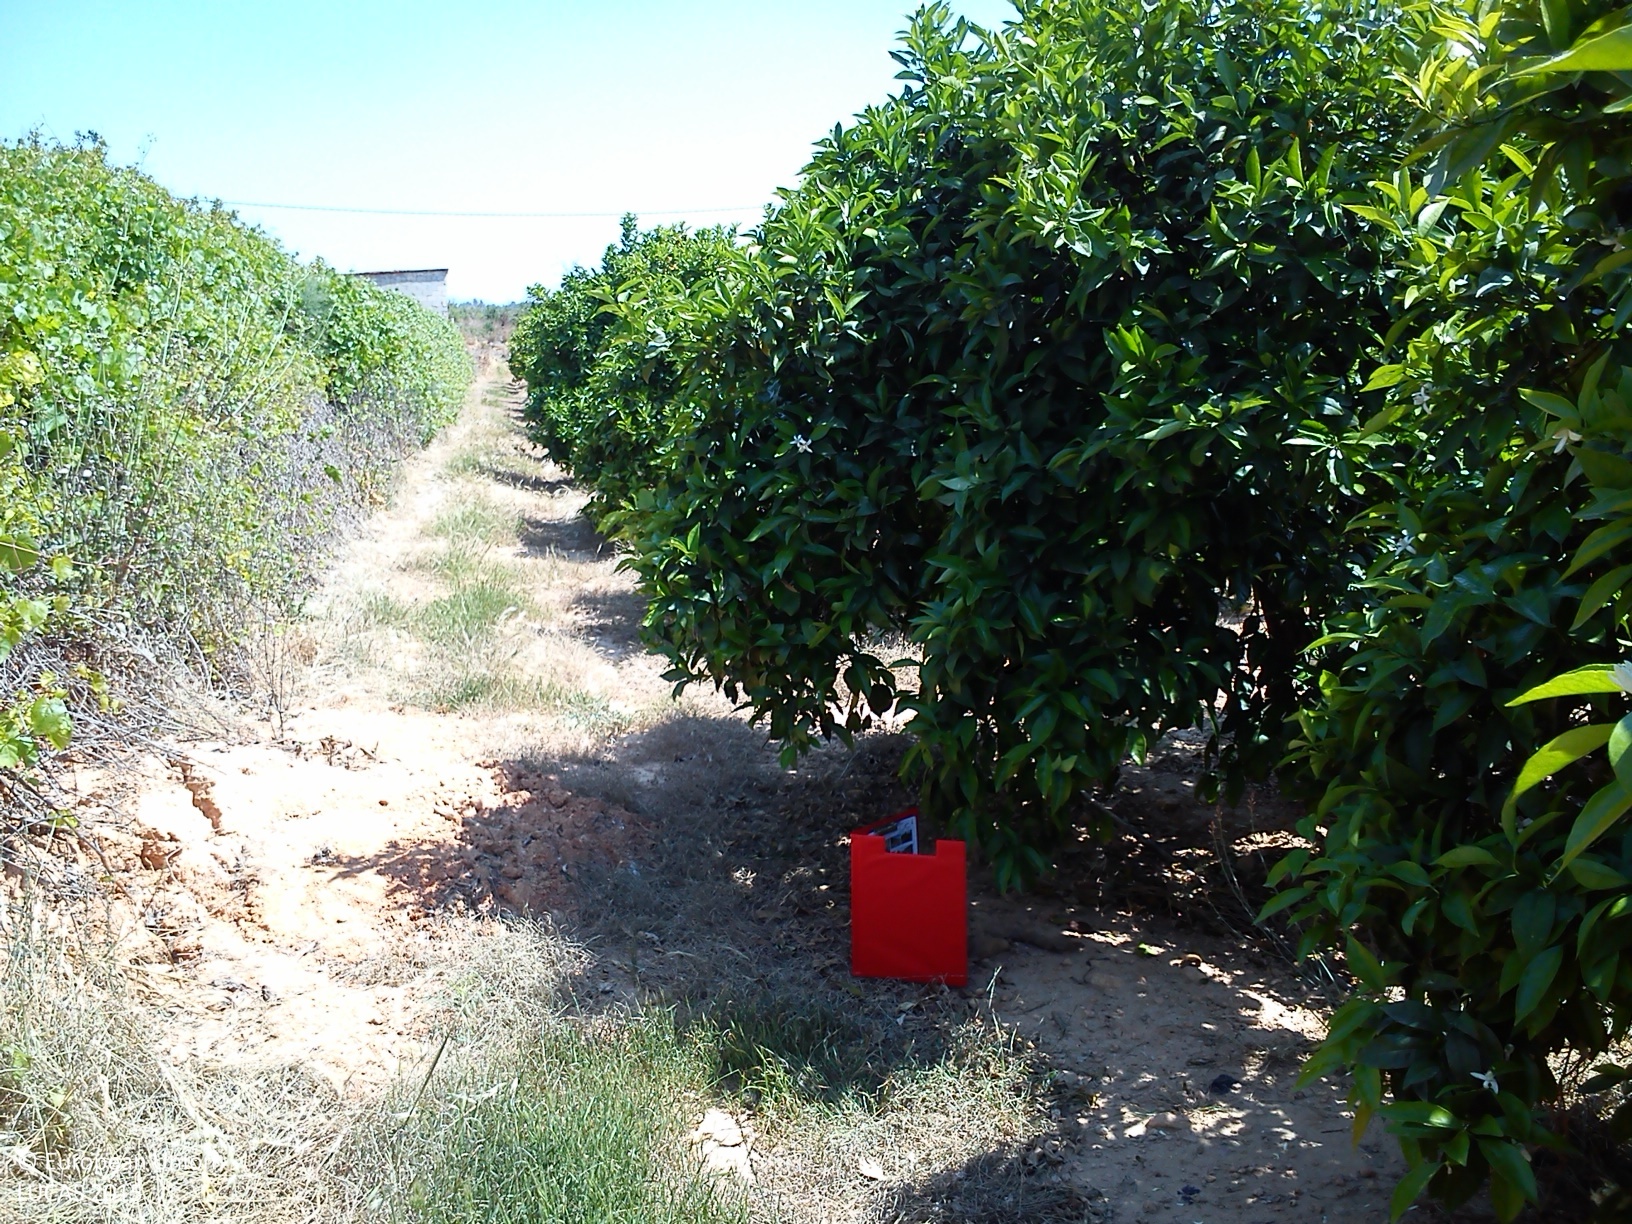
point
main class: Cropland
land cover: Oranges
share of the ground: 50 - 75 %
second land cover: Spontaneously vegetated surfaces
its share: < 10 %
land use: Agriculture (excluding fallow land and kitchen gardens)
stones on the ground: 10 - 25 %
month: April
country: ES
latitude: 39.6250
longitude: -0.7067
